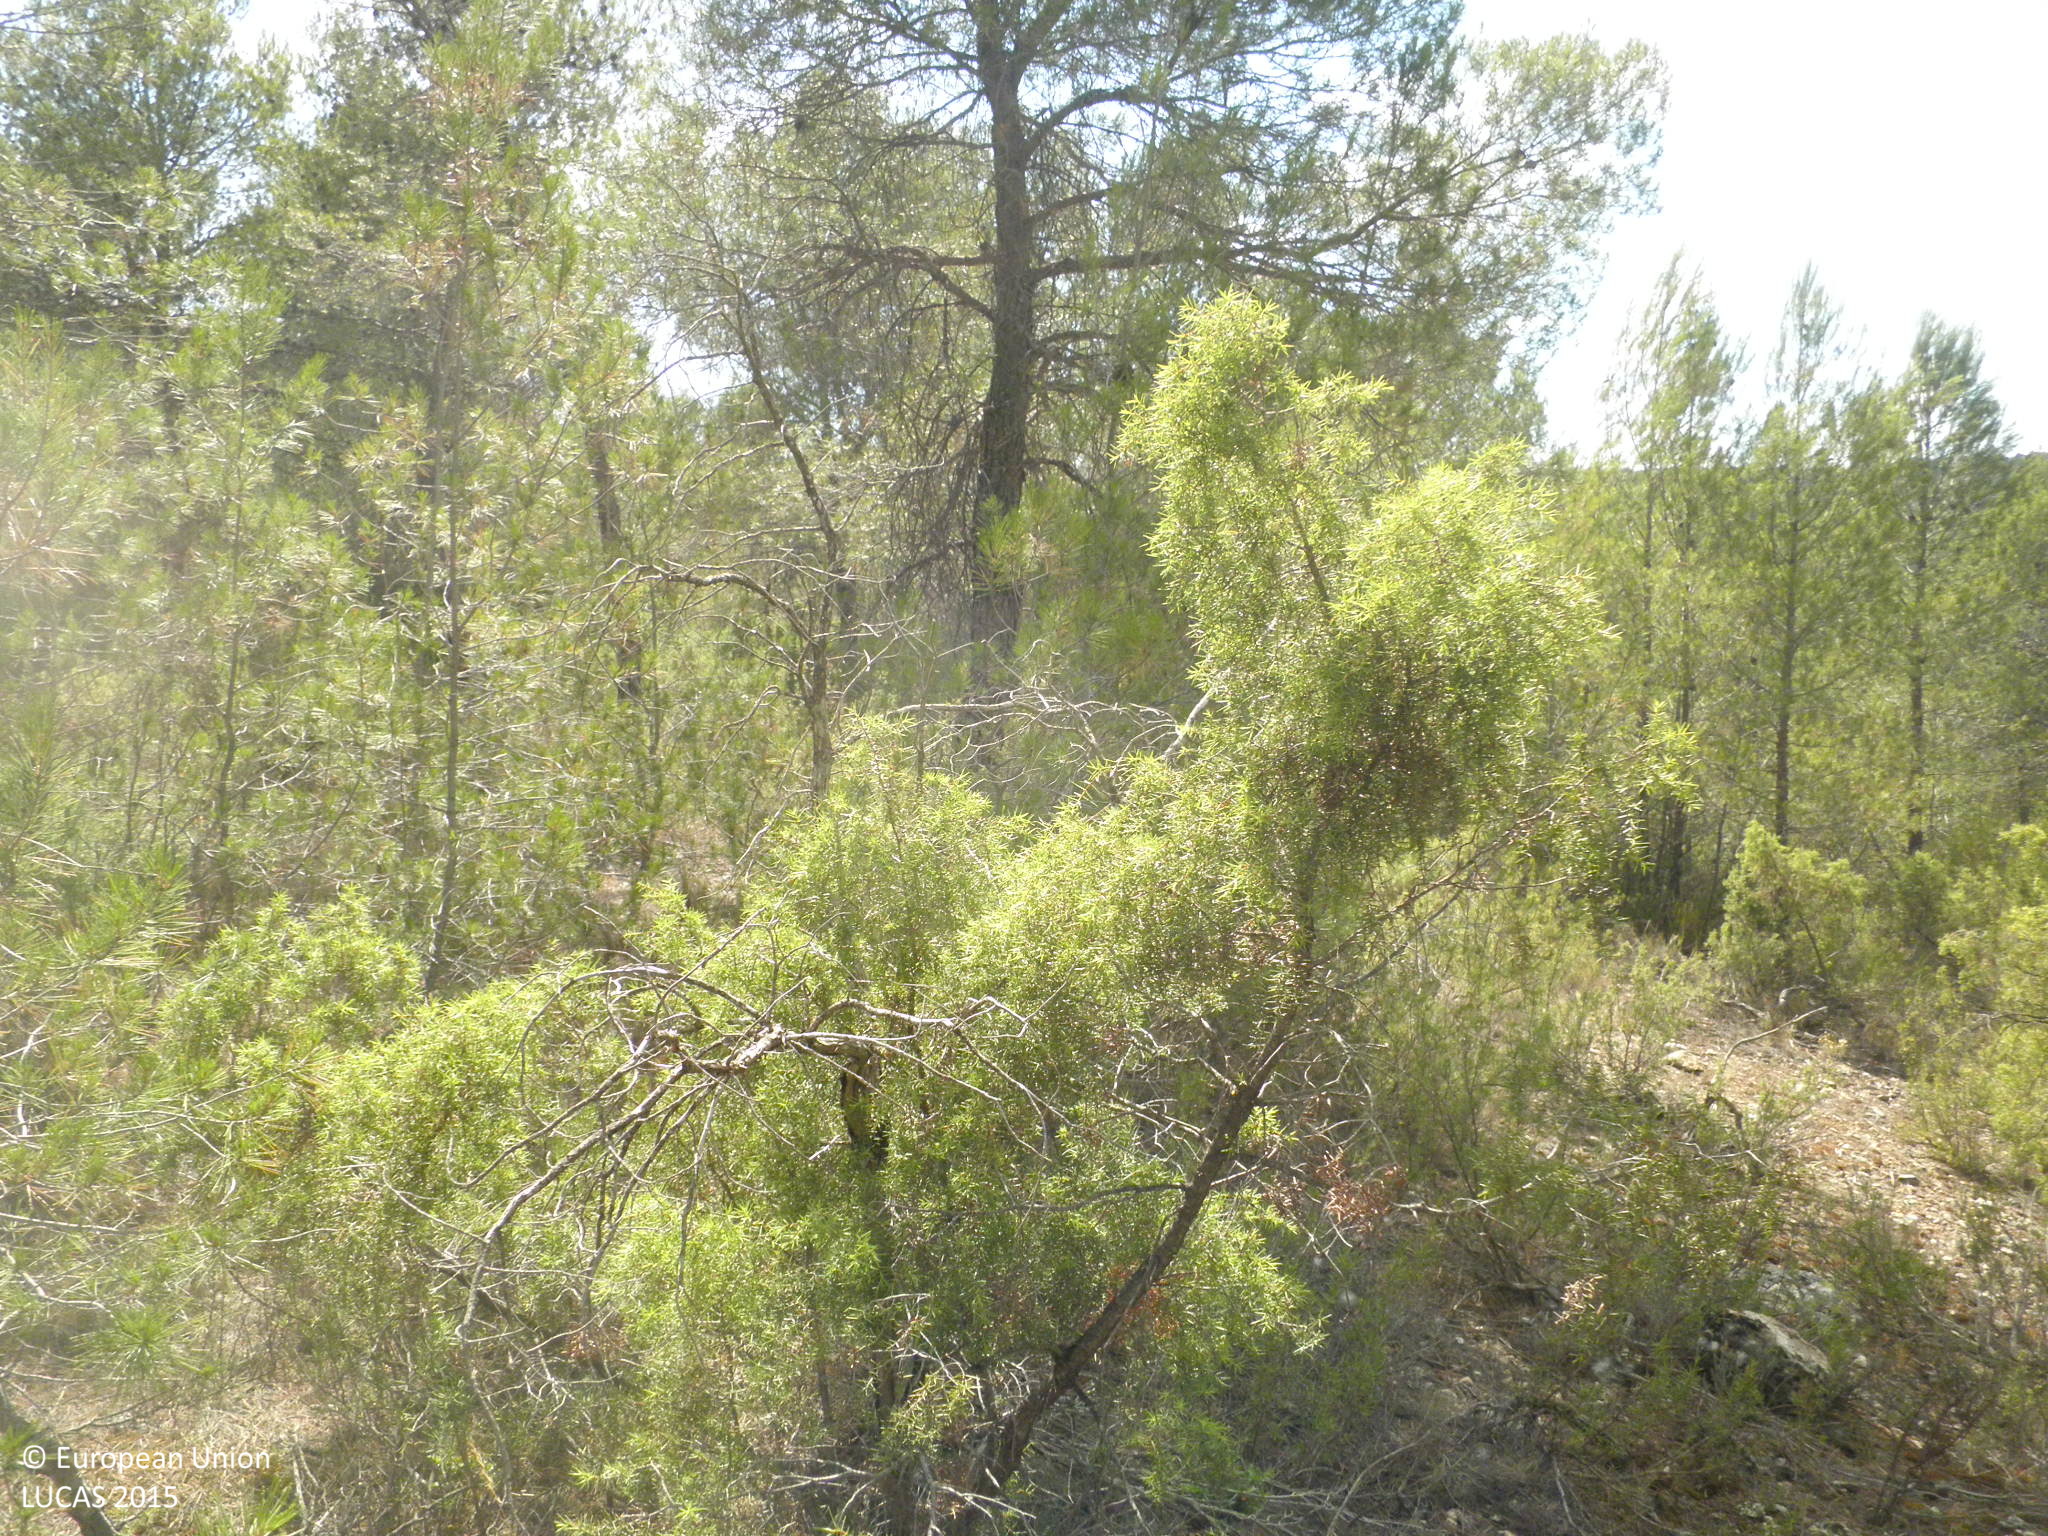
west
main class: Woodland
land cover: Pine dominated coniferous woodland
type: coniferous forest of the mediterranean region
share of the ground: 50 - 75 %
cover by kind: coniferous forest trees 50 %, shrubs 30 %, herbaceous plants 10 %, unconsolidated bare surface 10 %
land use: Semi-natural and natural areas not in use
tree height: > 5 m
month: July
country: ES
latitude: 39.6289
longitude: -1.6219
